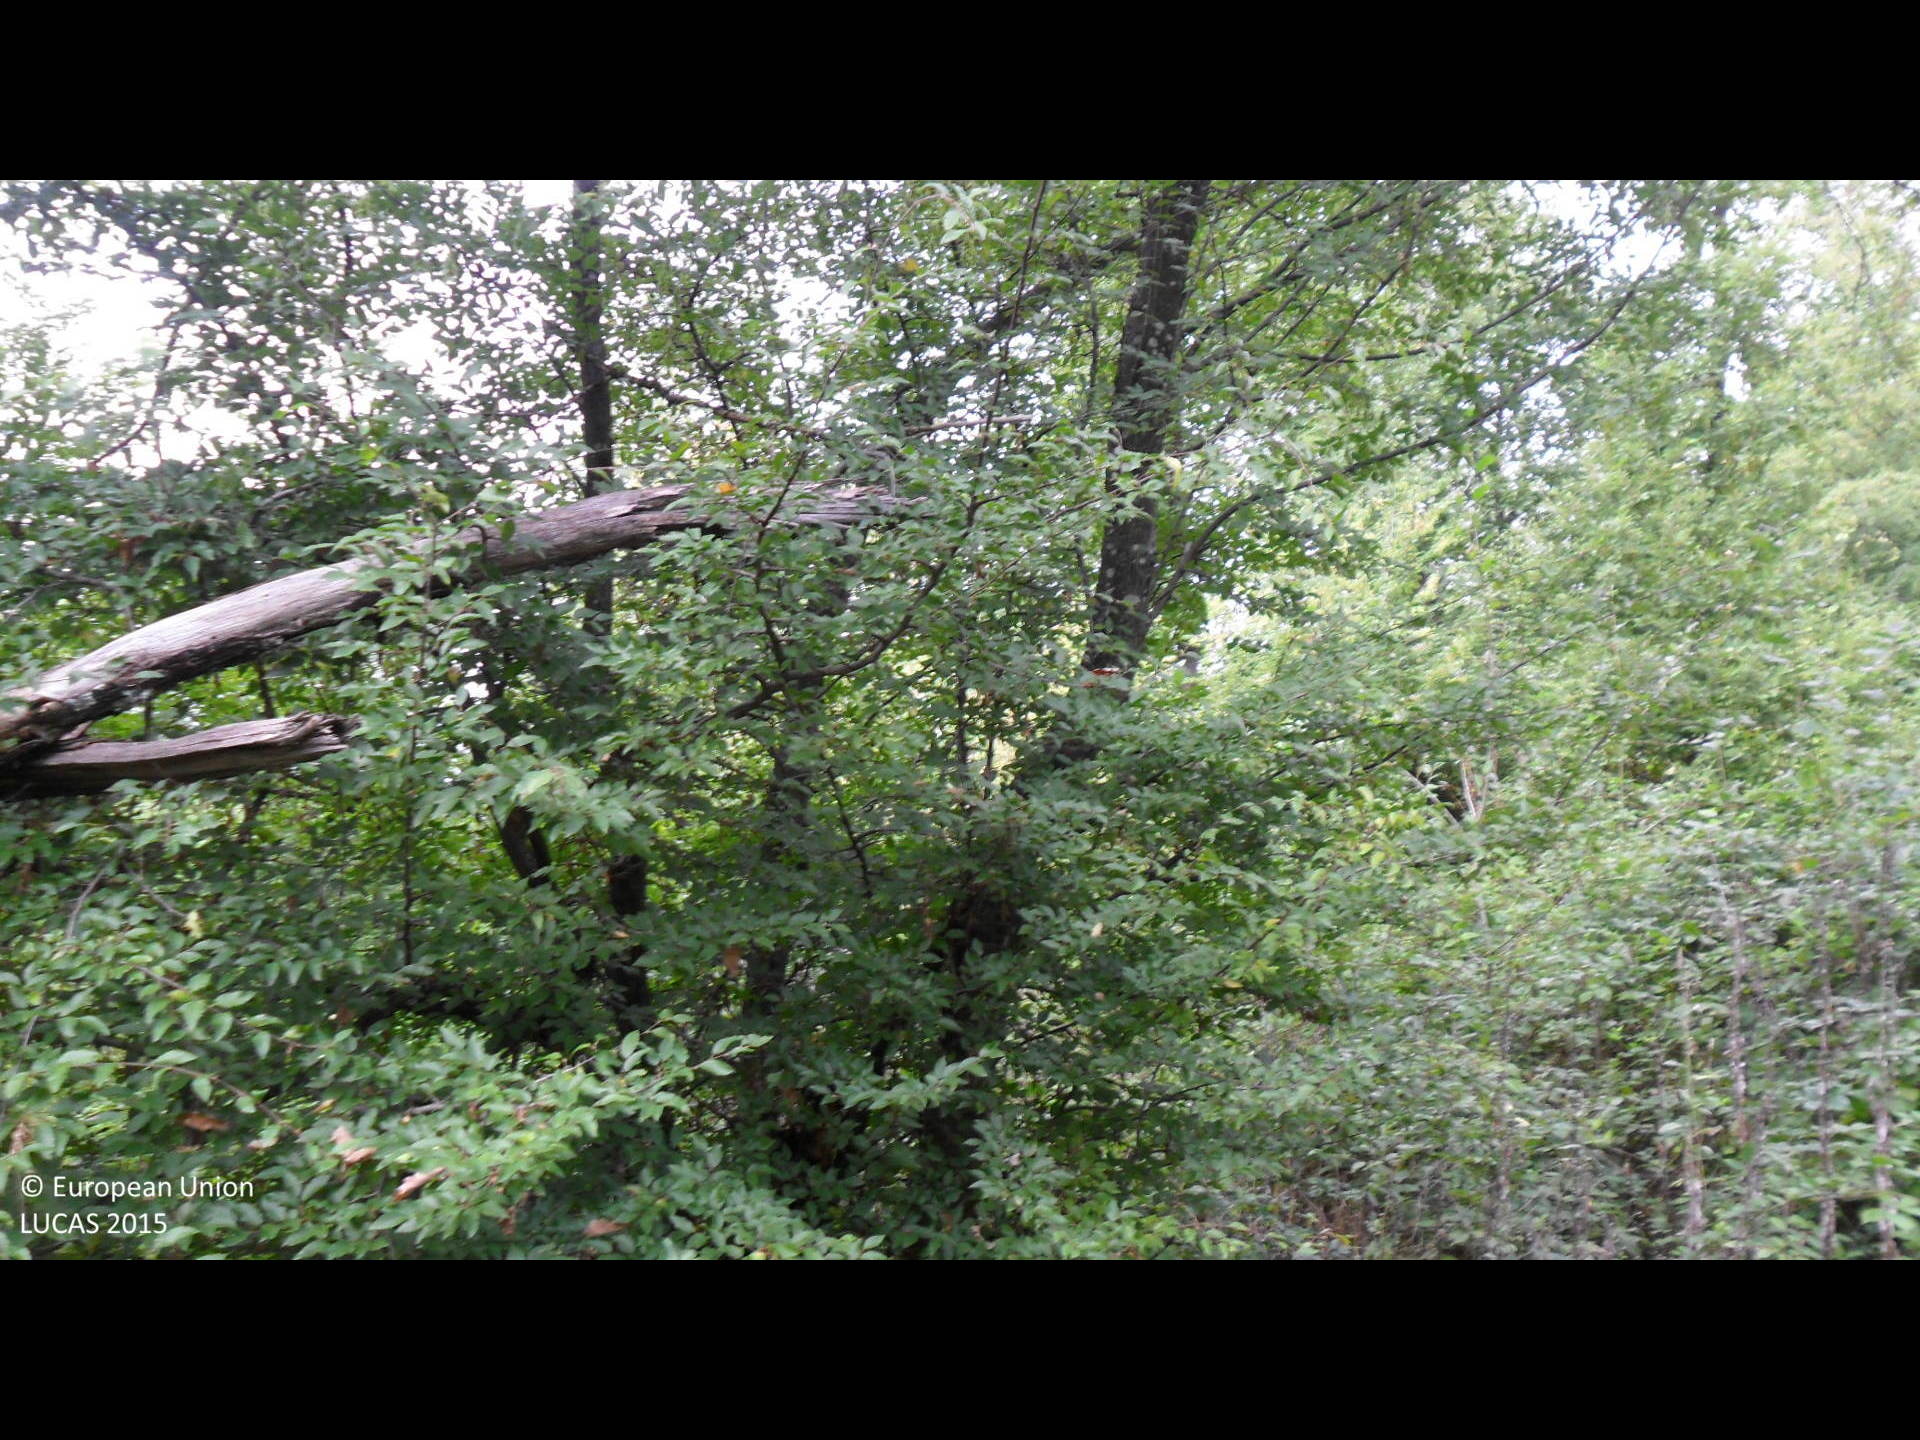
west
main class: Woodland
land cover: Broadleaved woodland
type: thermophilous deciduous forest
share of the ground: > 75 %
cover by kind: broadleaved forest trees 90 %, unconsolidated bare surface 10 %
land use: Forestry
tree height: > 5 m
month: September
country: BG
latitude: 43.0375
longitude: 26.3842
